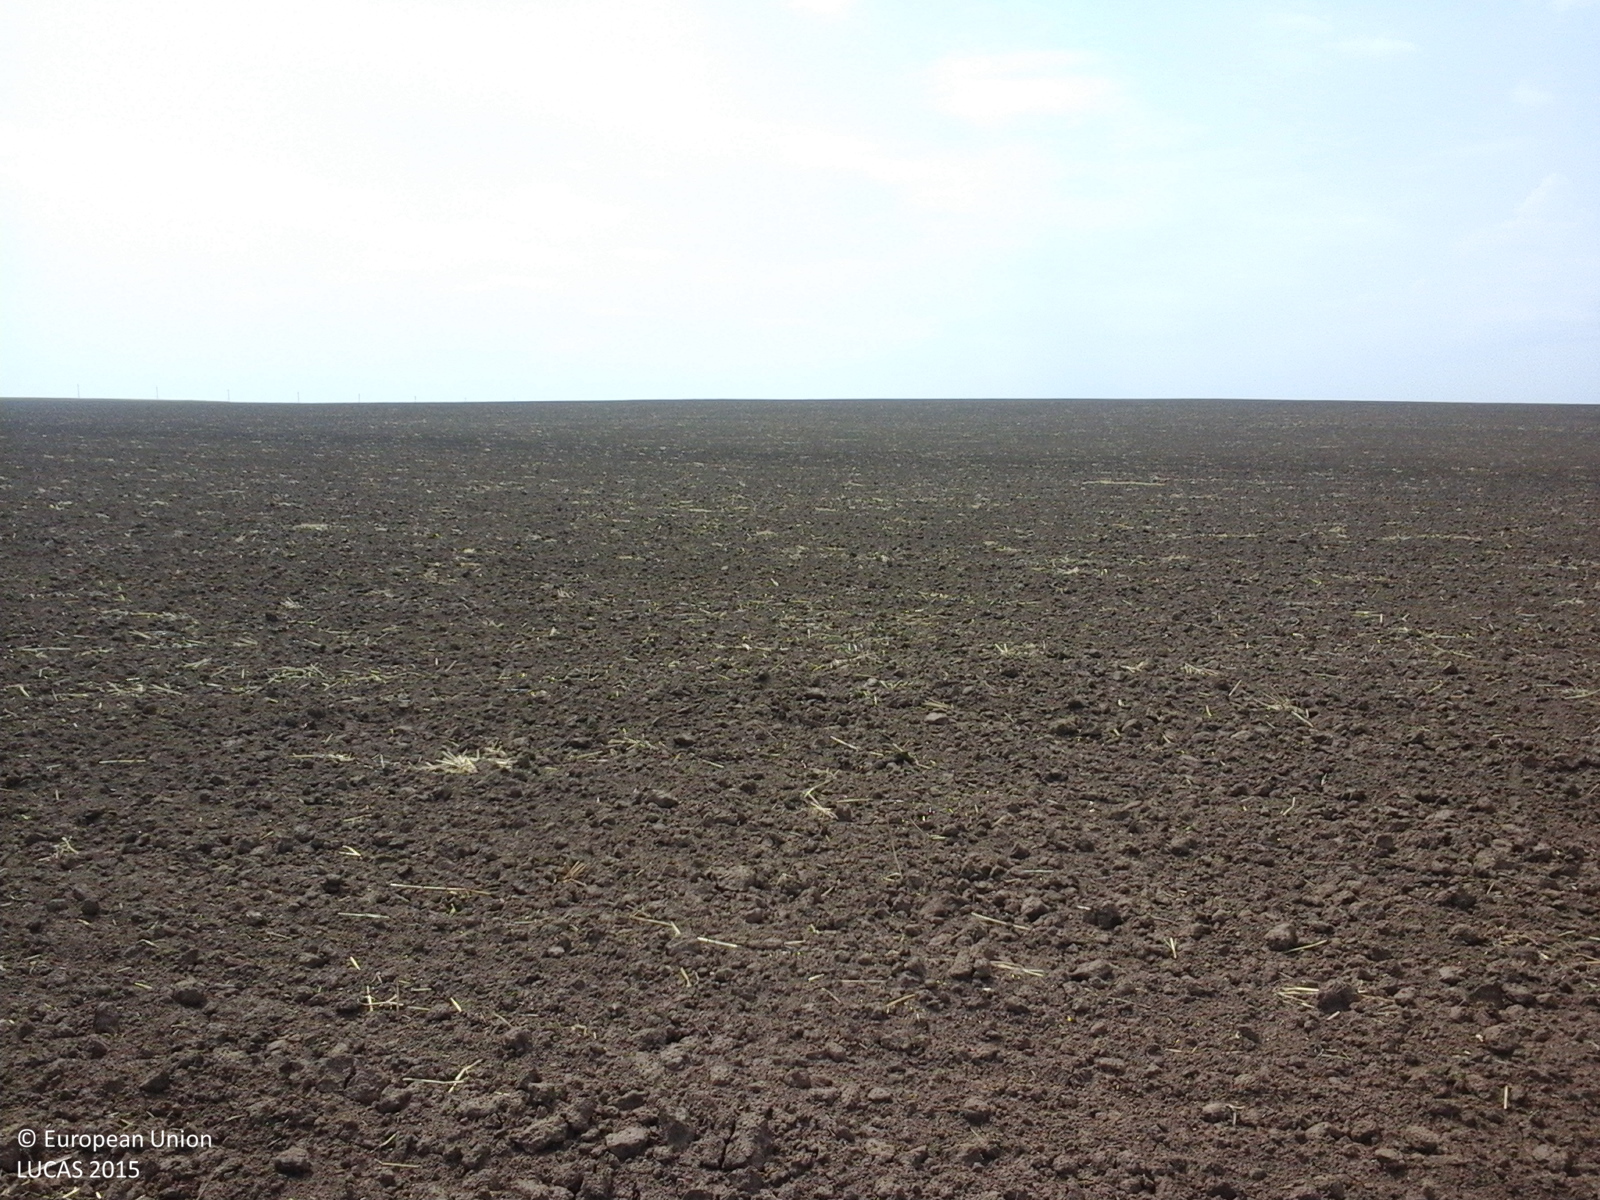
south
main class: Cropland
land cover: Common wheat
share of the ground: < 10 %
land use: Agriculture (excluding fallow land and kitchen gardens)
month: August
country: RO
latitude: 43.8575
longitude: 28.0546
